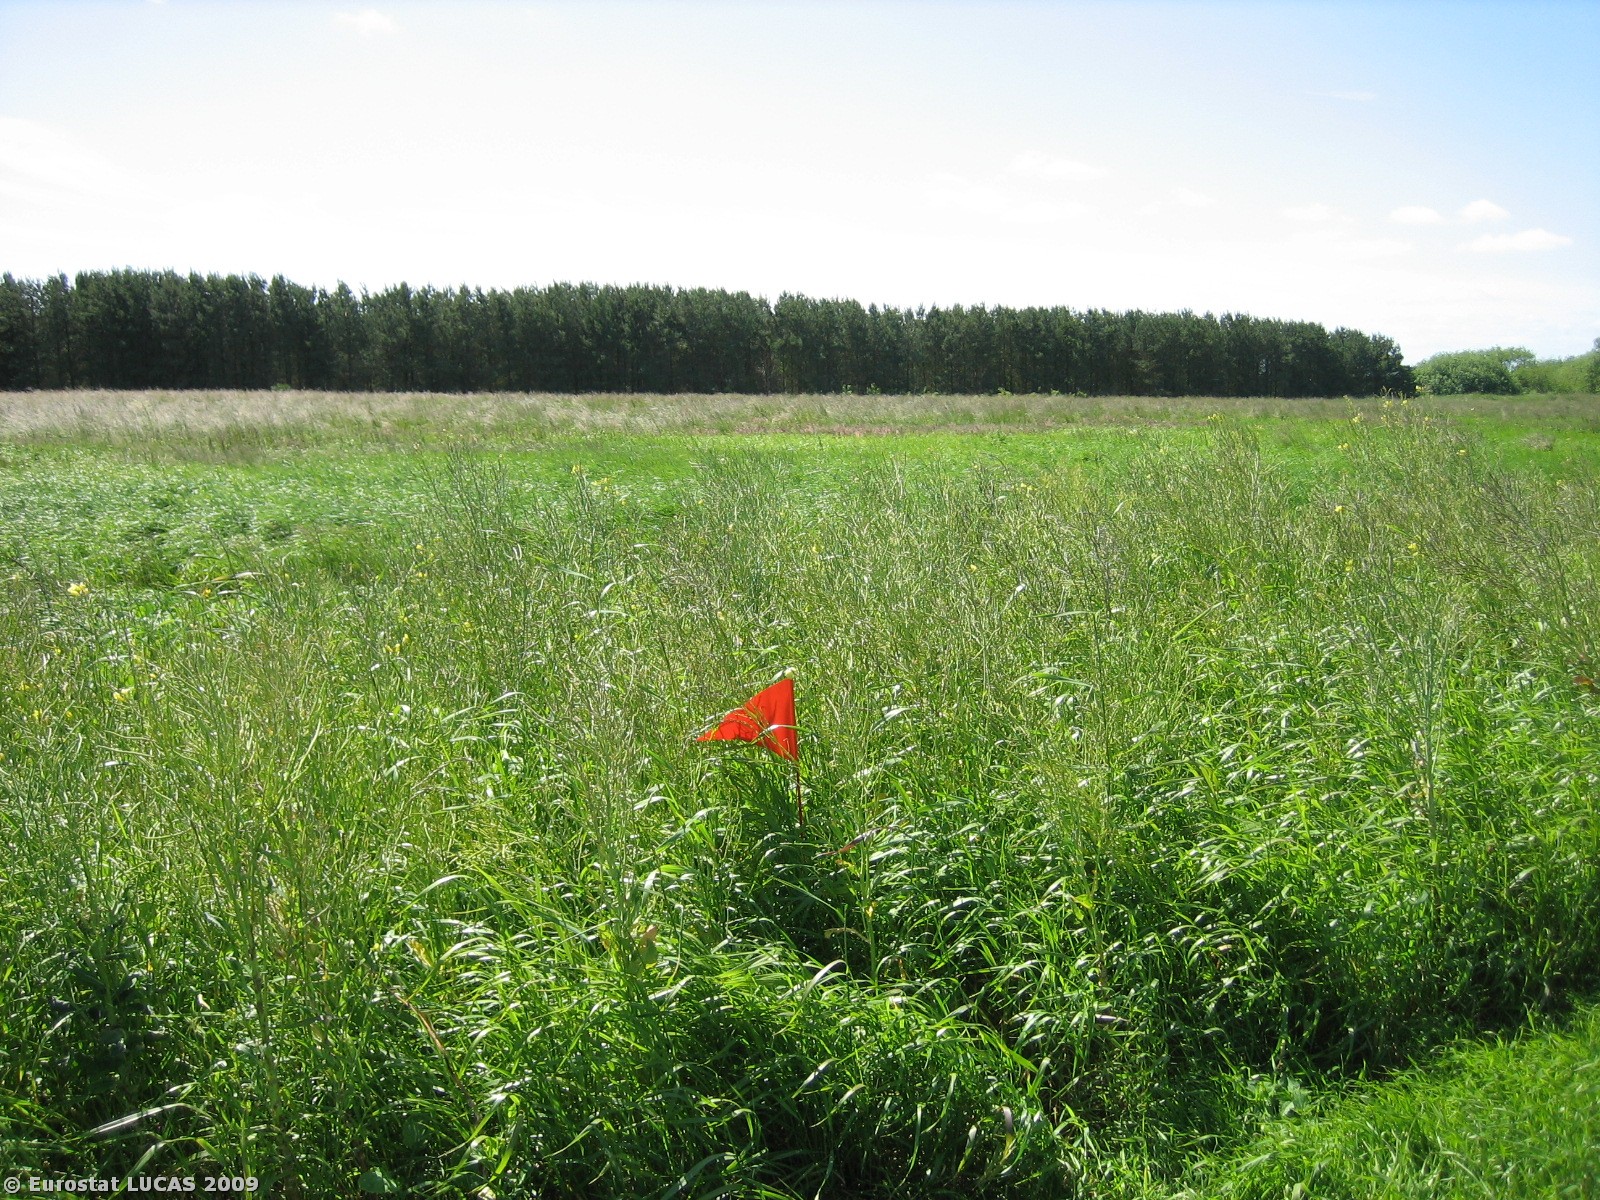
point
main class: Cropland
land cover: Rape and turnip rape
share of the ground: > 75 %
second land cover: Grassland without tree/shrub cover
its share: > 75 %
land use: Agriculture (excluding fallow land and kitchen gardens)
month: June
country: DK
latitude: 55.7384
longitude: 10.0159
